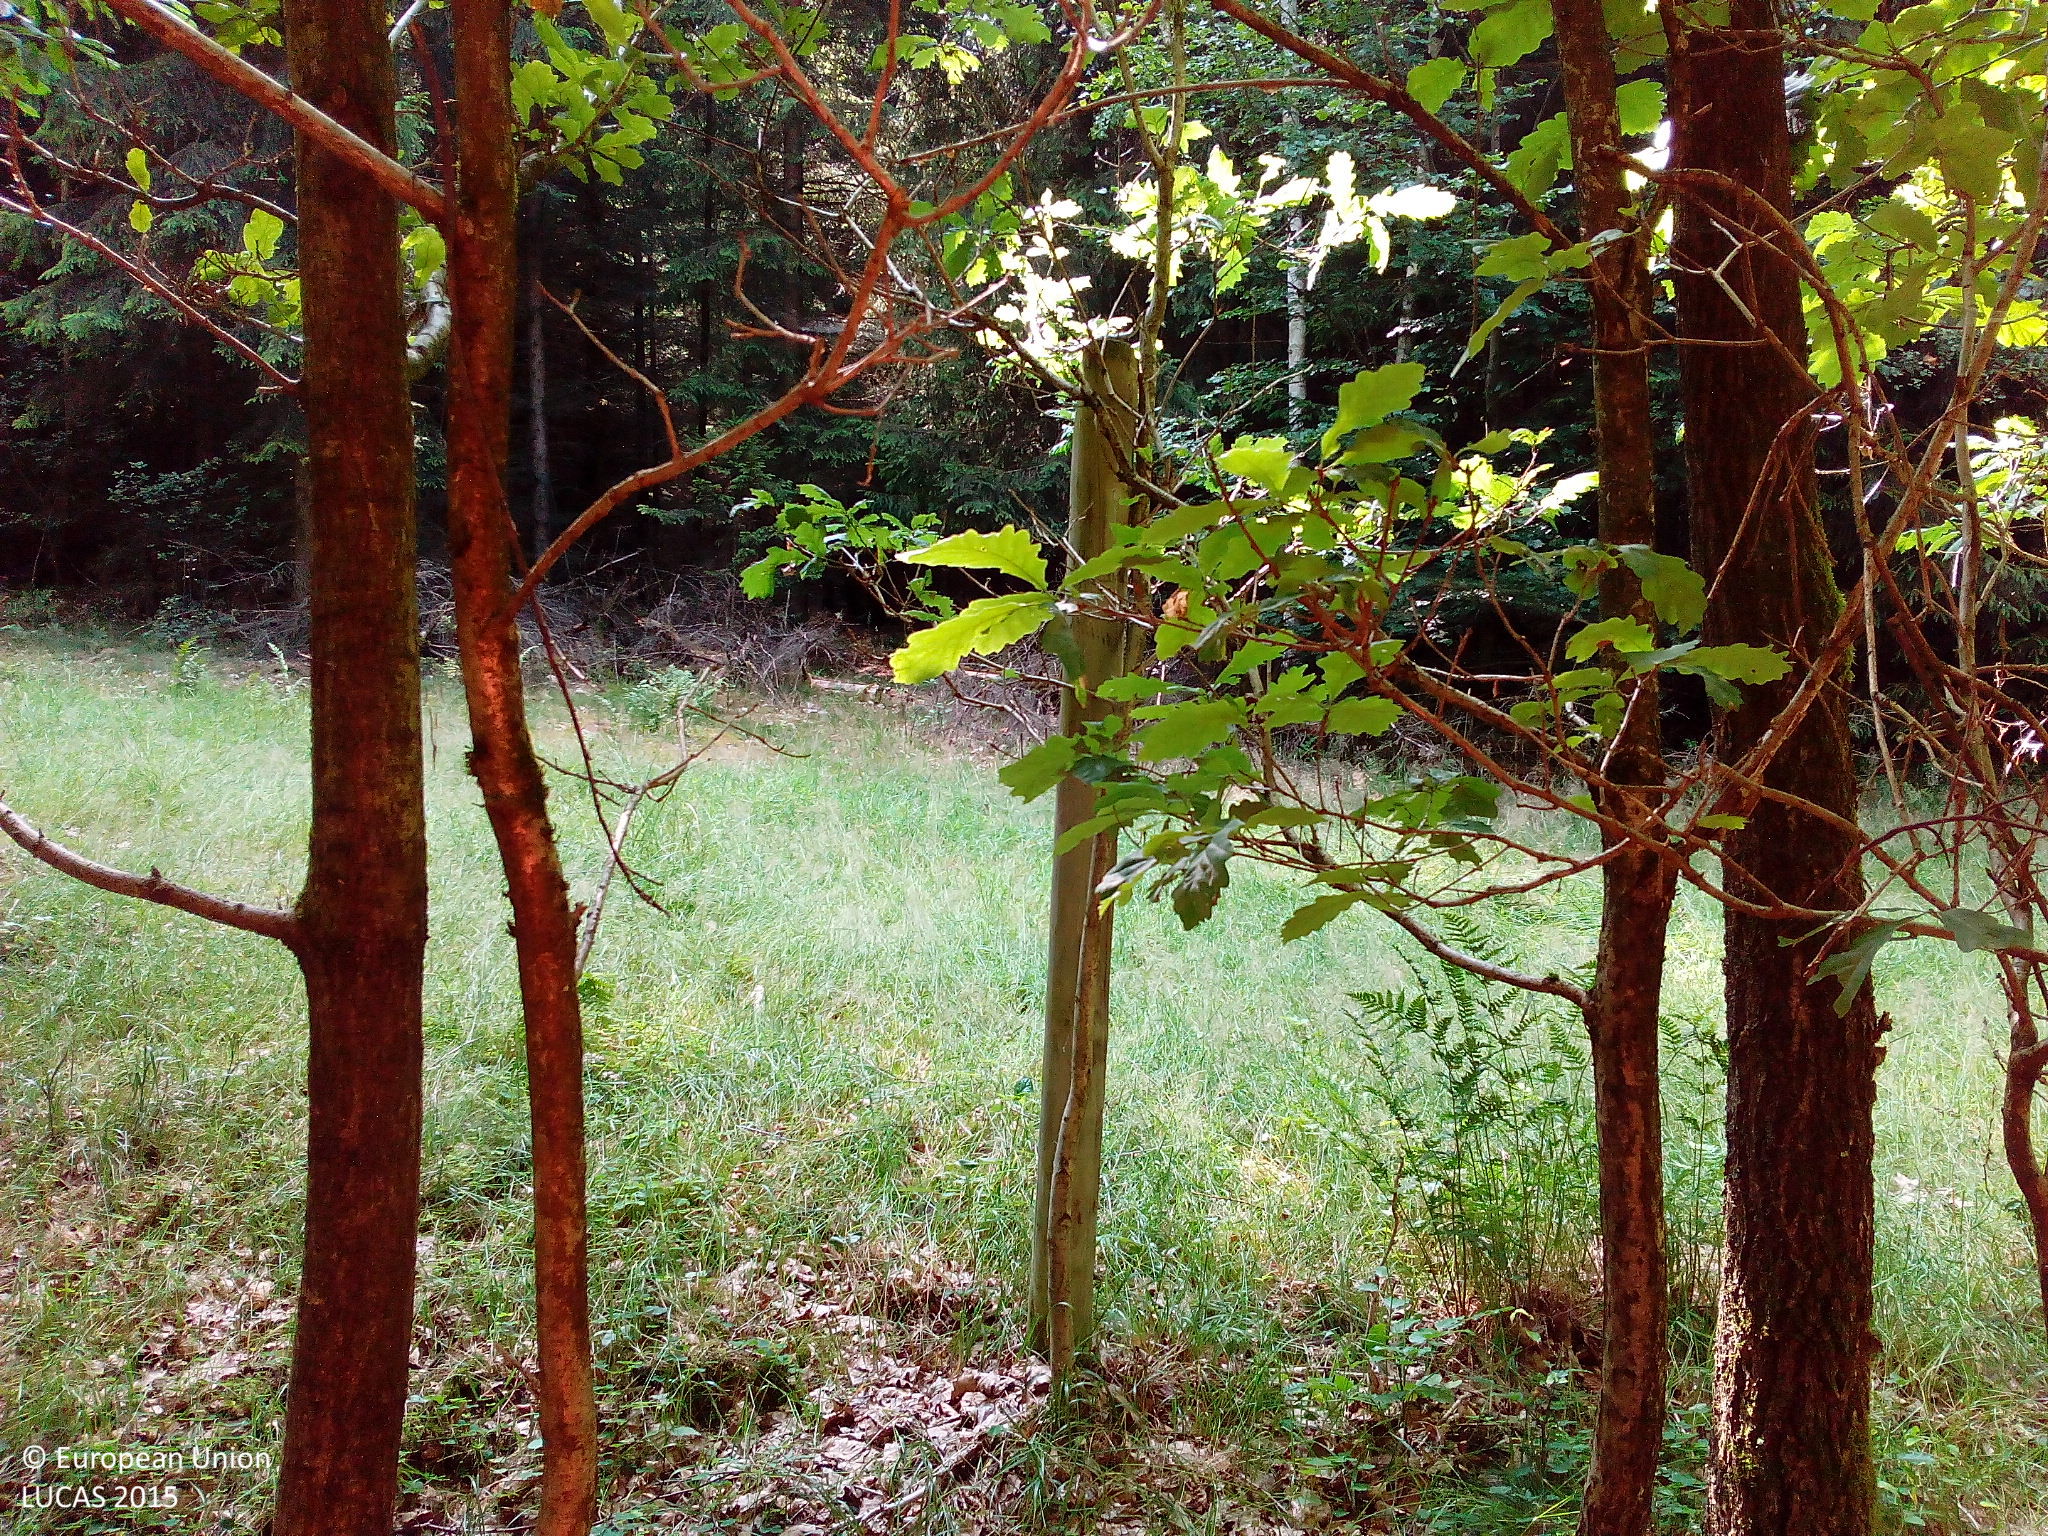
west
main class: Woodland
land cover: Spruce dominated mixed woodland
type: hemiboreal forest and nemoral coniferous forest and mixed broadleaved-coniferous forest
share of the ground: > 75 %
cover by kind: coniferous forest trees 60 %, broadleaved forest trees 40 %
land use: Forestry
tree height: > 5 m
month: July
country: DE
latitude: 50.6157
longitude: 9.8728
